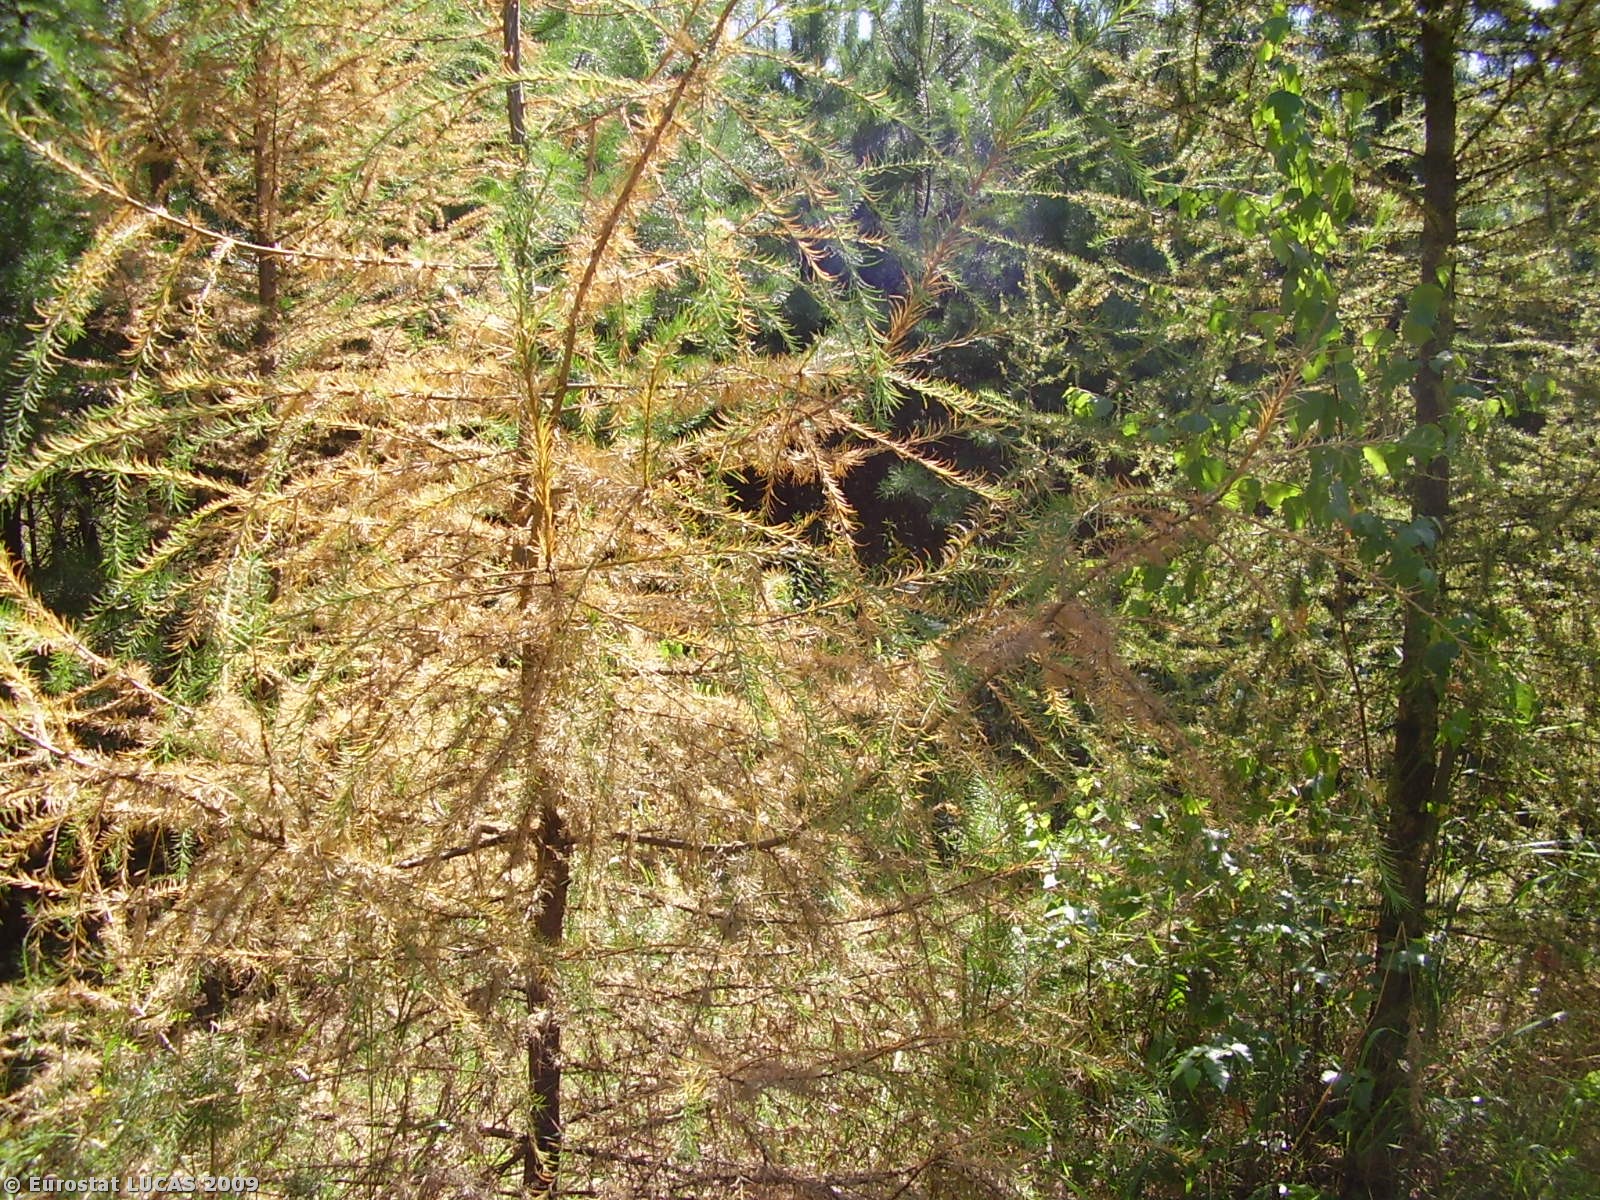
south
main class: Woodland
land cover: Coniferous woodland
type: hemiboreal forest and nemoral coniferous forest and mixed broadleaved-coniferous forest
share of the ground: > 75 %
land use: Forestry
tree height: > 5 m
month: August
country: PL
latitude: 51.3346
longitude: 16.7983
